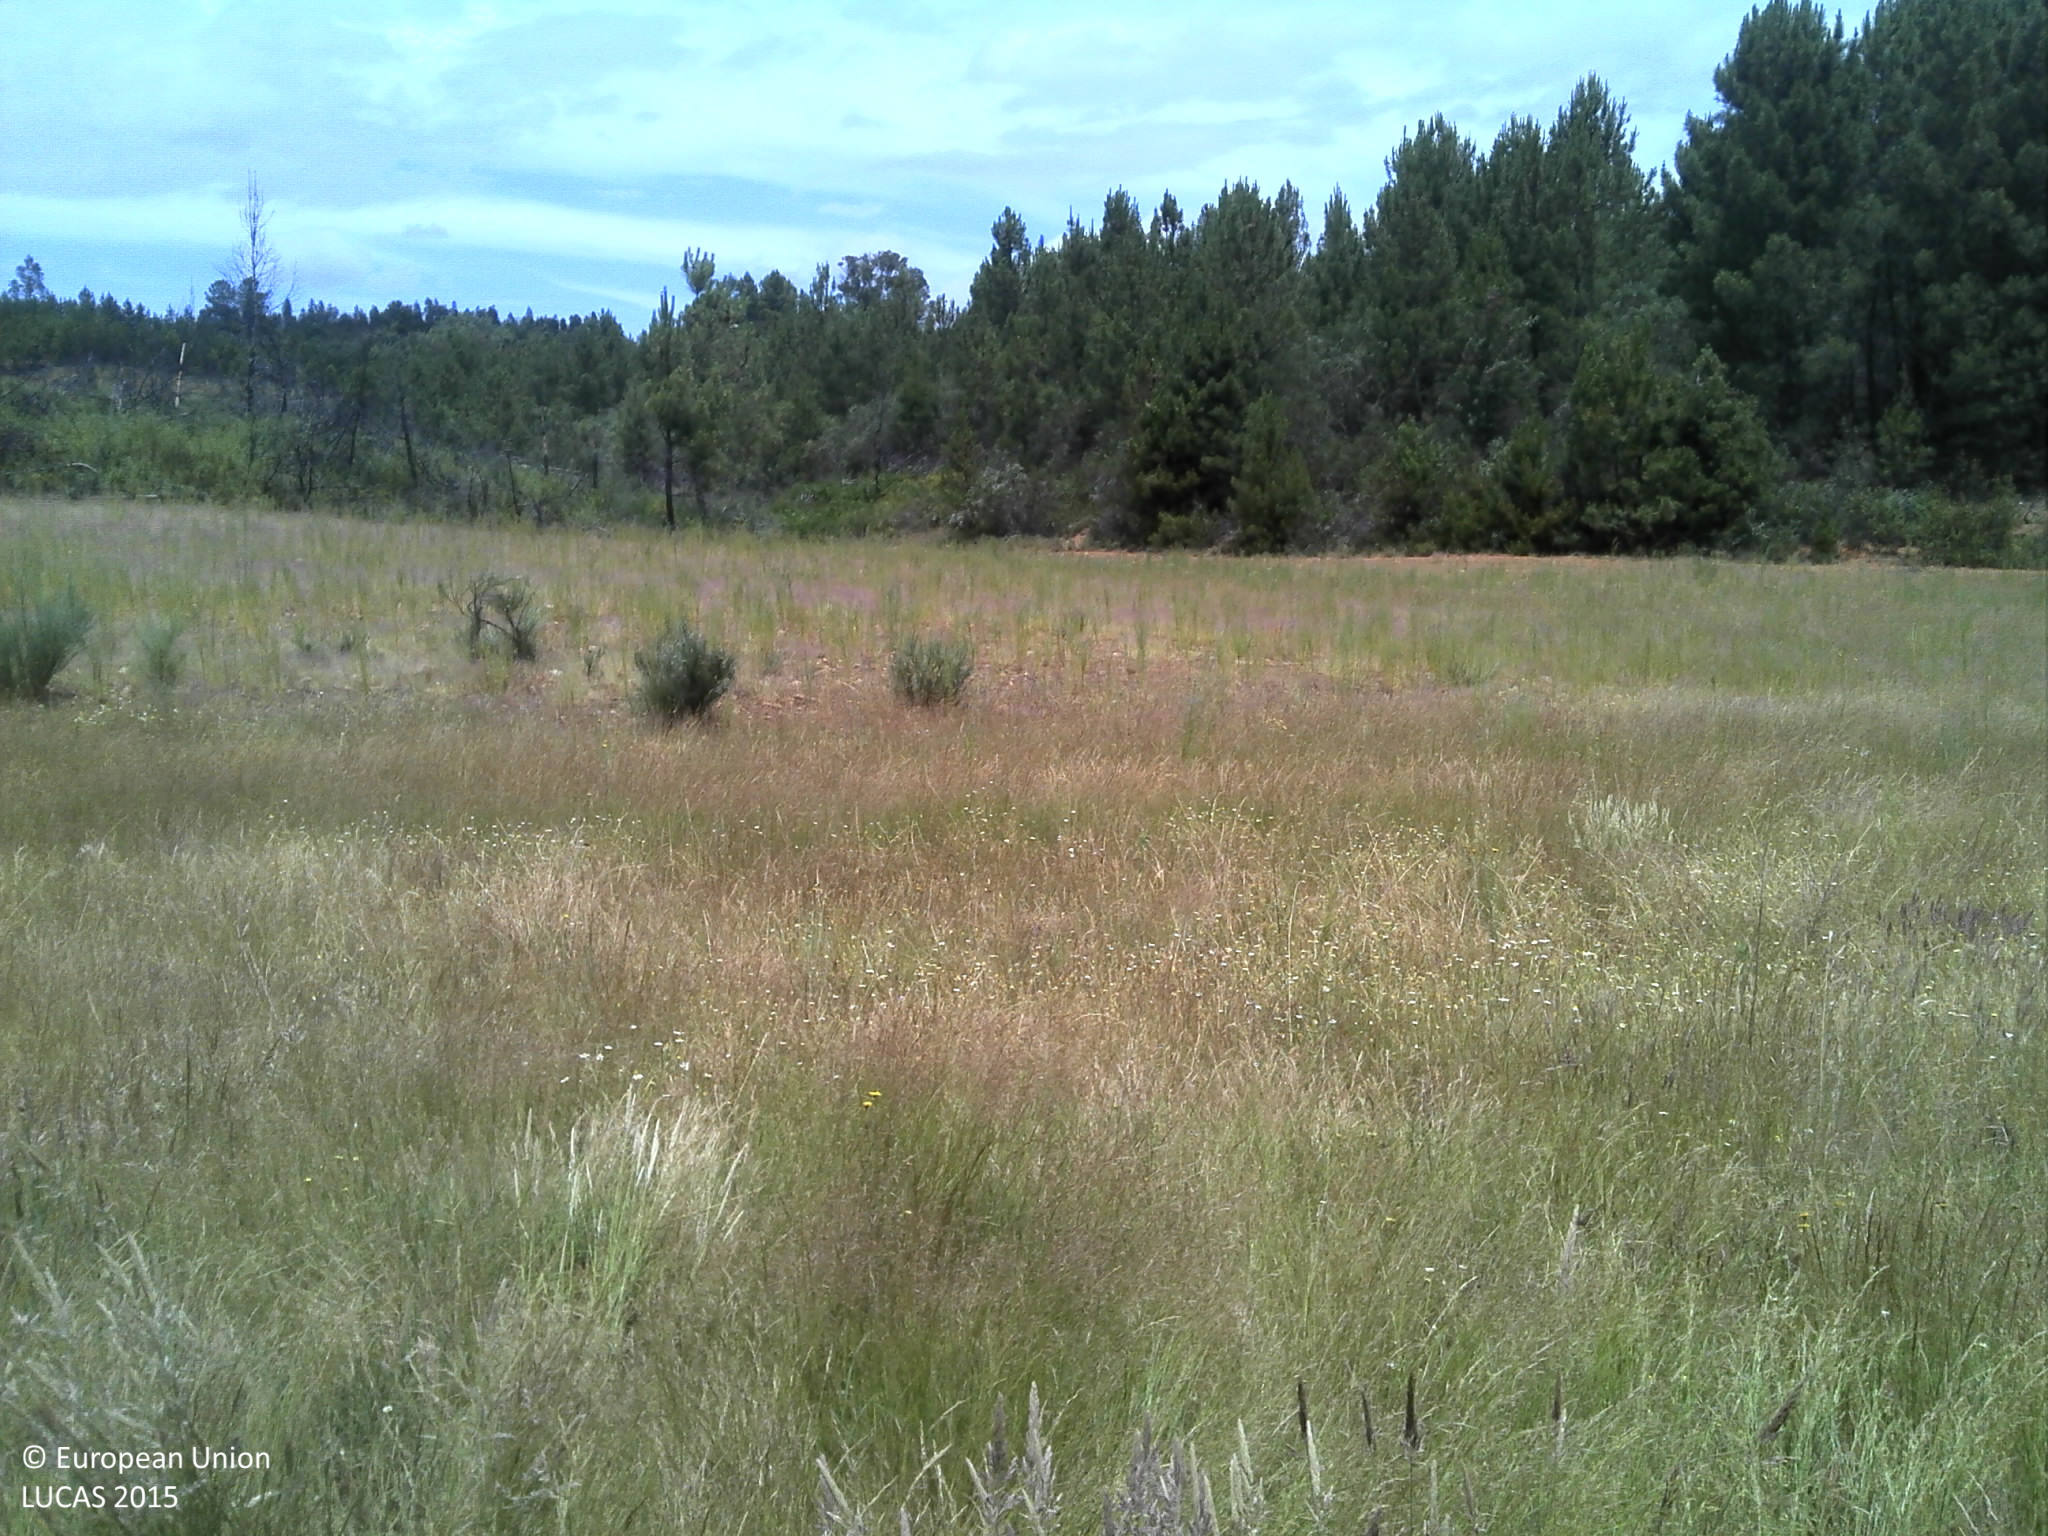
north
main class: Woodland
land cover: Broadleaved woodland
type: exotic forest
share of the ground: > 75 %
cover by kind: broadleaved forest trees 85 %, unconsolidated bare surface 10 %, shrubs 5 %
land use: Forestry
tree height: > 5 m
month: June
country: PT
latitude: 40.1482
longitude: -7.3453
